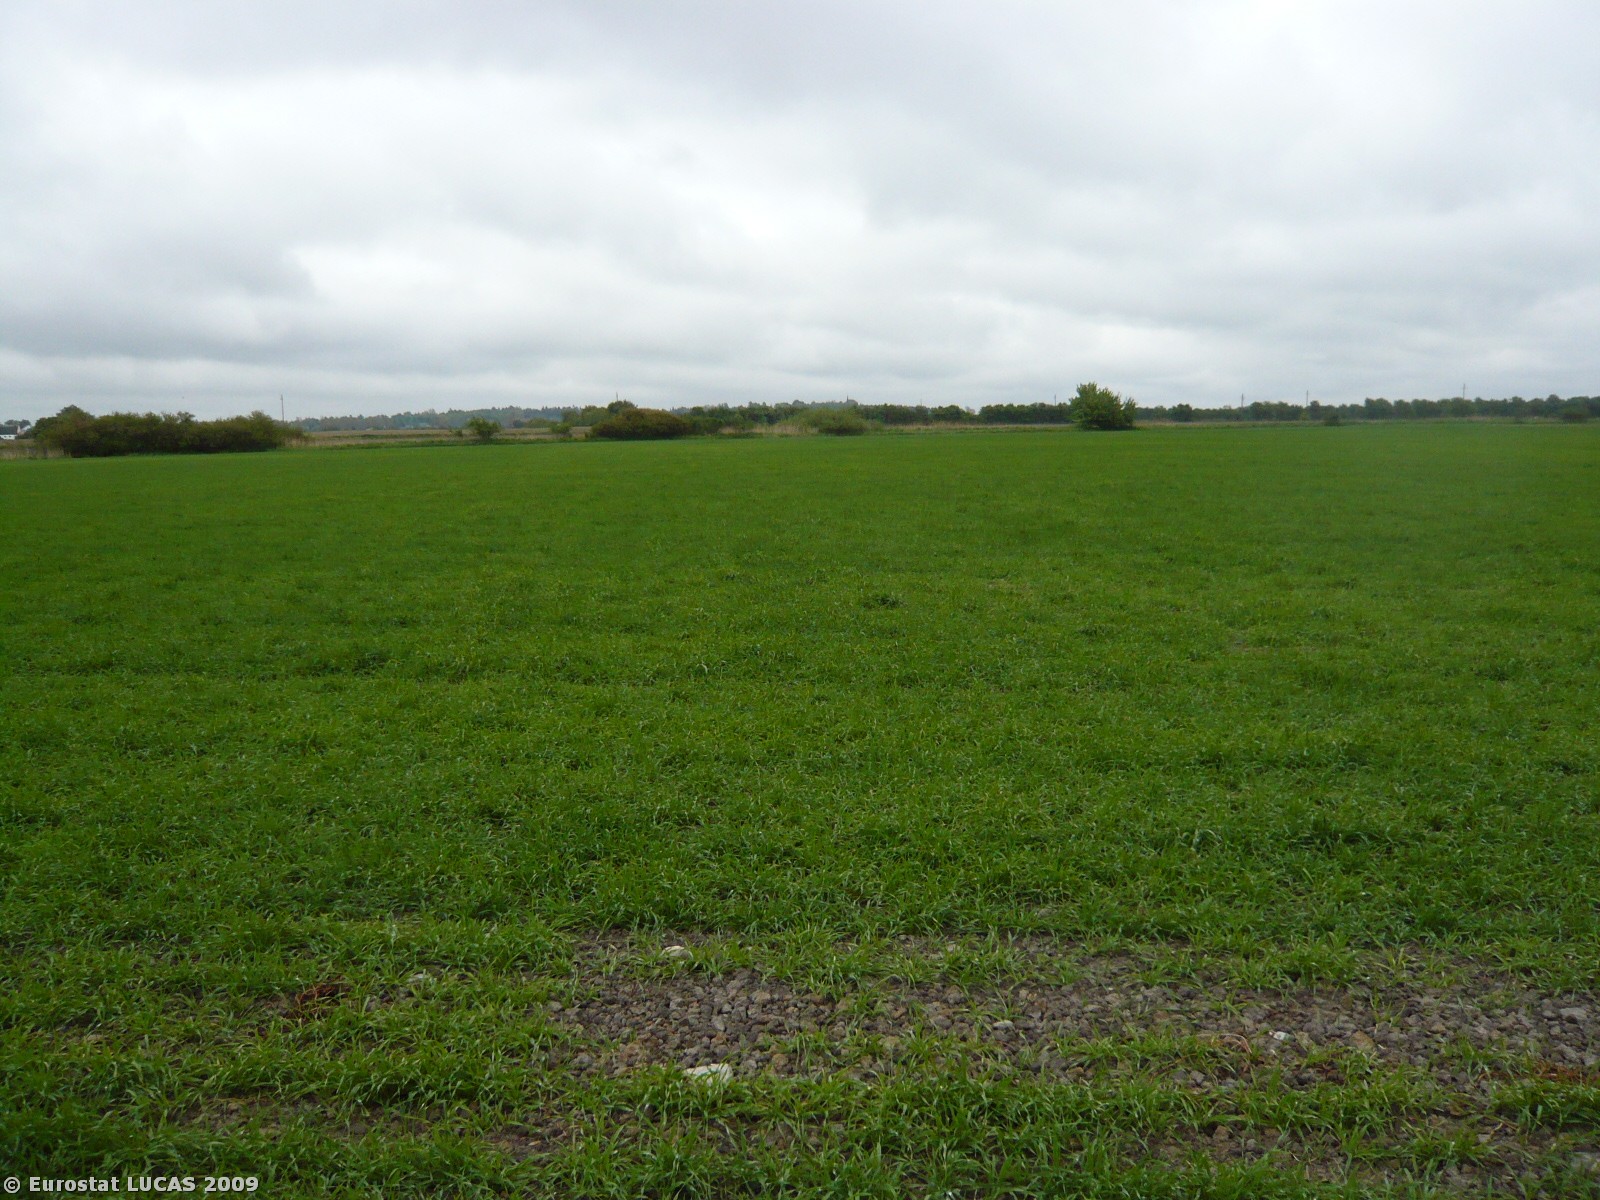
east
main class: Cropland
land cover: Barley
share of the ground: > 75 %
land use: Agriculture (excluding fallow land and kitchen gardens)
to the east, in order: Barley; Shrubland with sparse tree cover; Maize
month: May
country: DK
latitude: 55.1148
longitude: 11.7703
